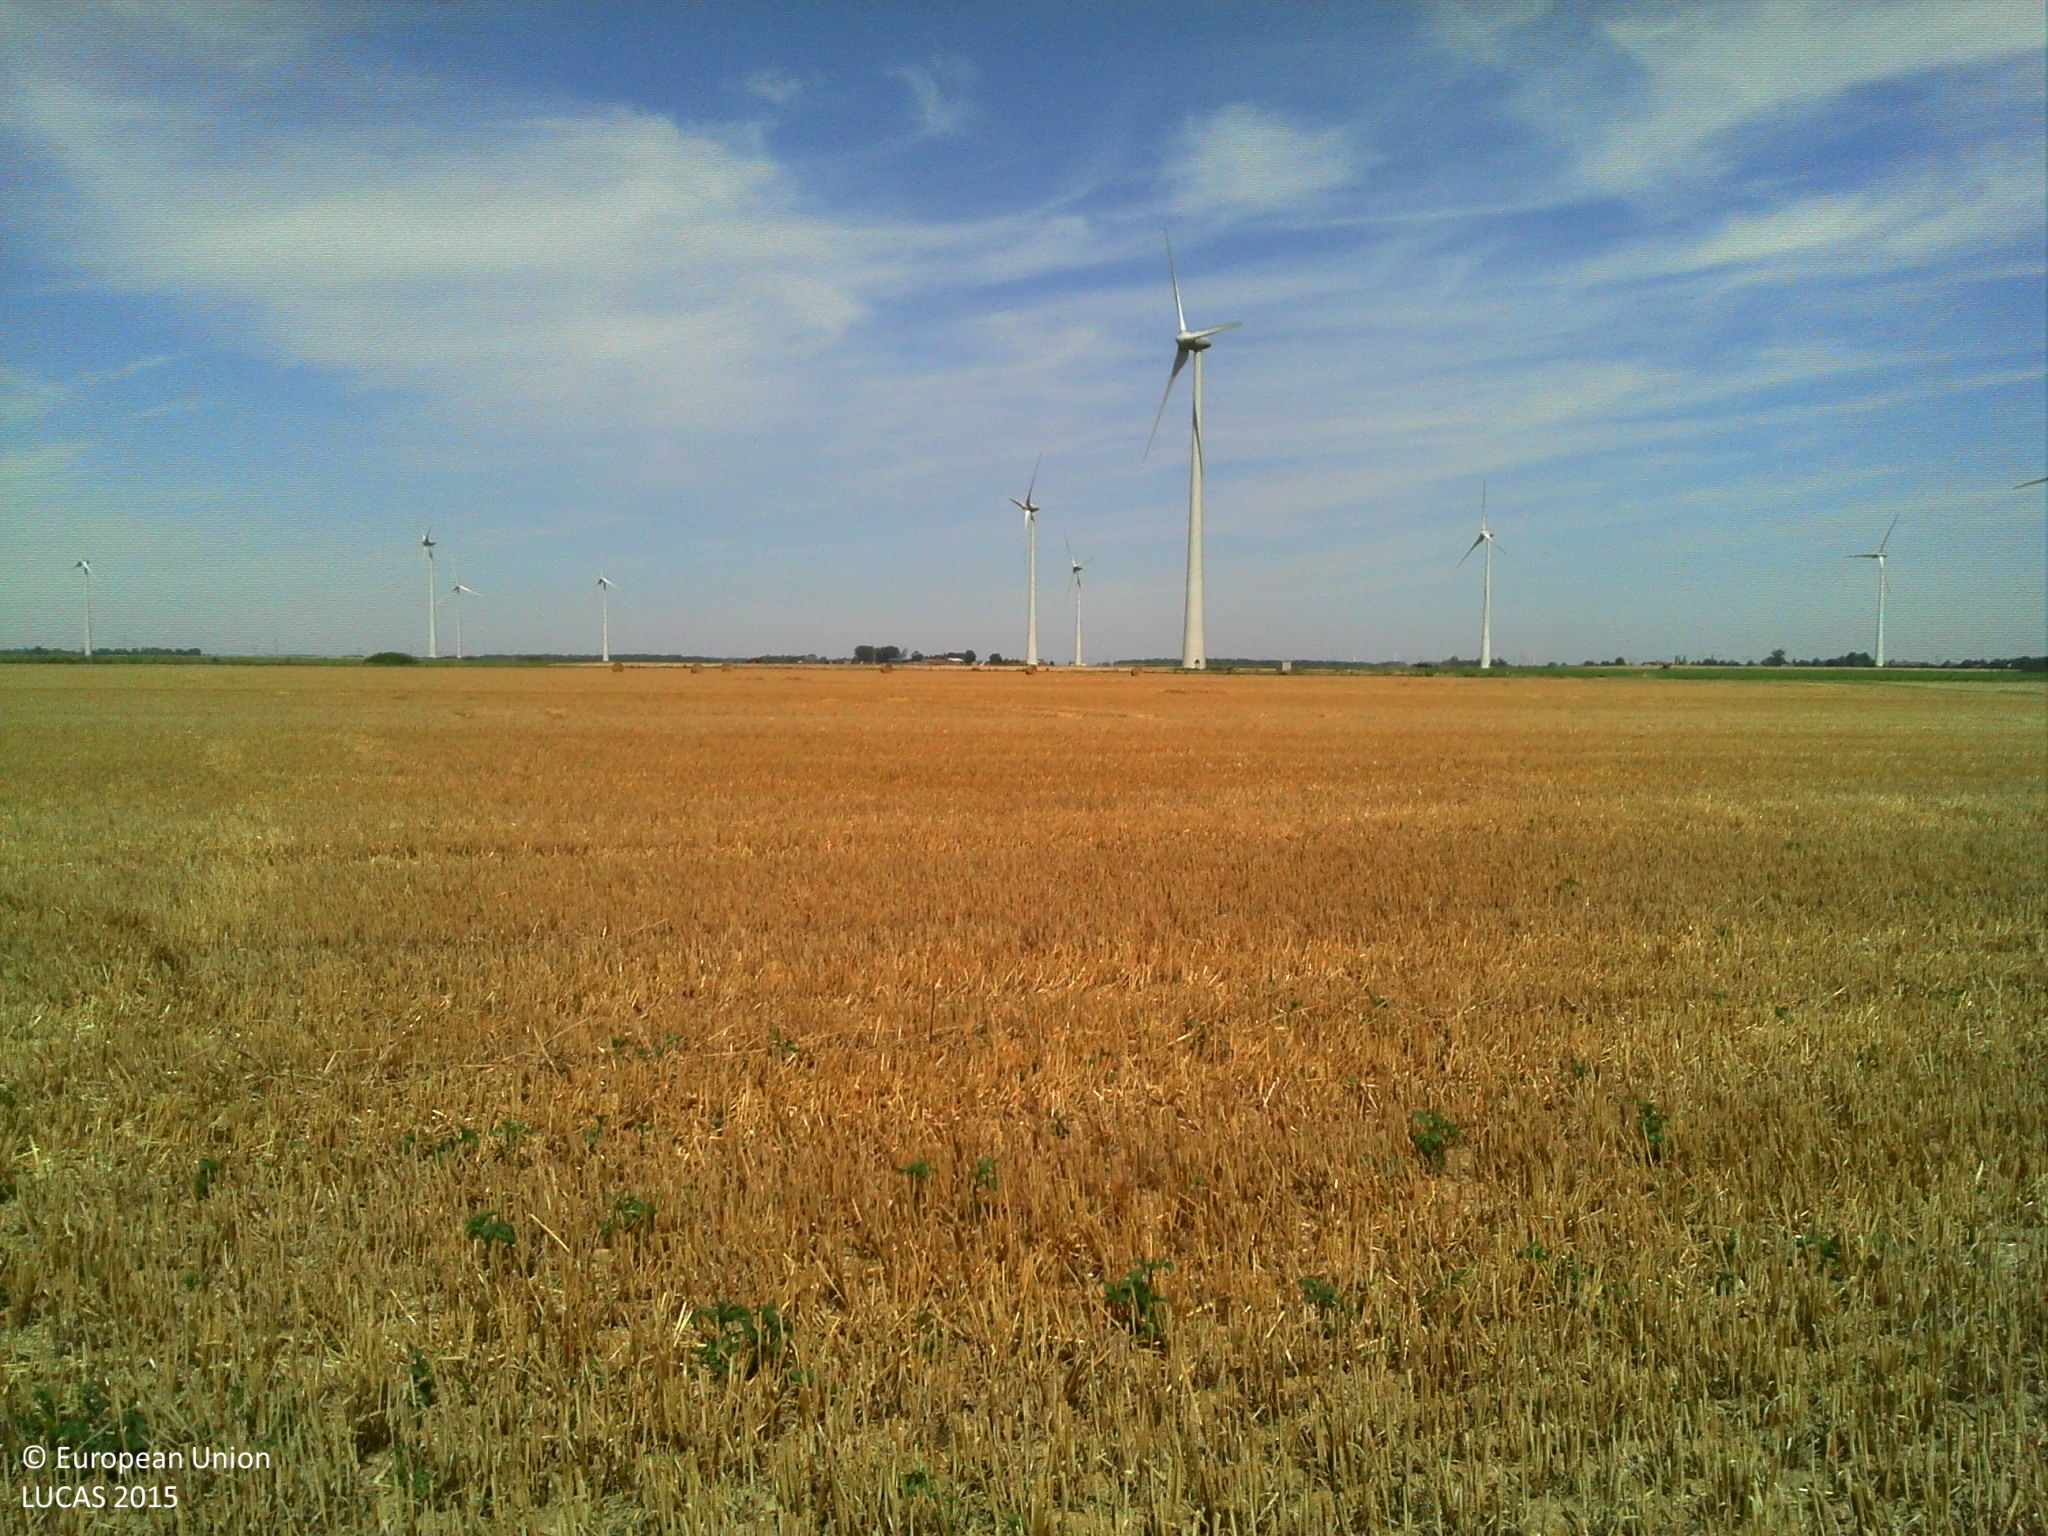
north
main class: Cropland
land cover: Common wheat
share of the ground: > 75 %
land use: Agriculture (excluding fallow land and kitchen gardens)
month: August
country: FR
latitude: 49.7068
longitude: 2.8483
